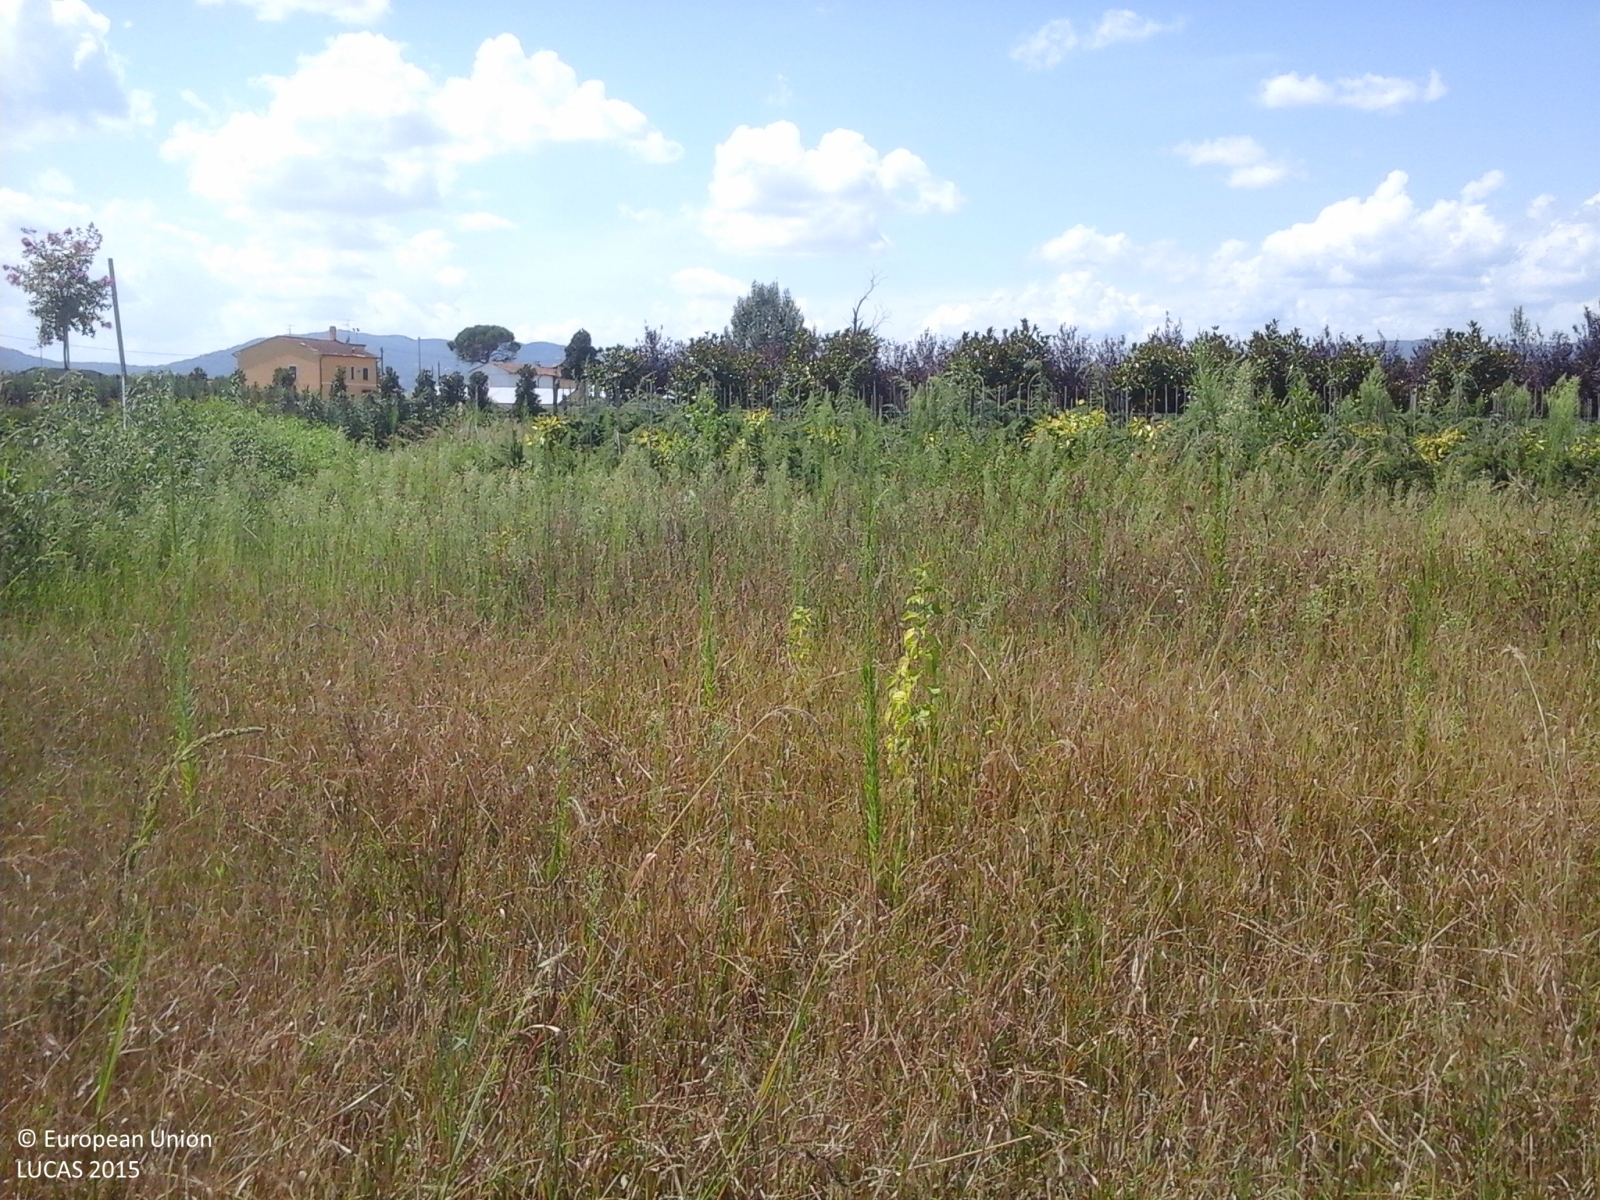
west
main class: Grassland
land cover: Spontaneously vegetated surfaces
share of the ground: > 75 %
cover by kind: herbaceous plants 95 %, shrubs 5 %
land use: Agriculture (excluding fallow land and kitchen gardens)
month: August
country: IT
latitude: 43.9132
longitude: 10.9564
